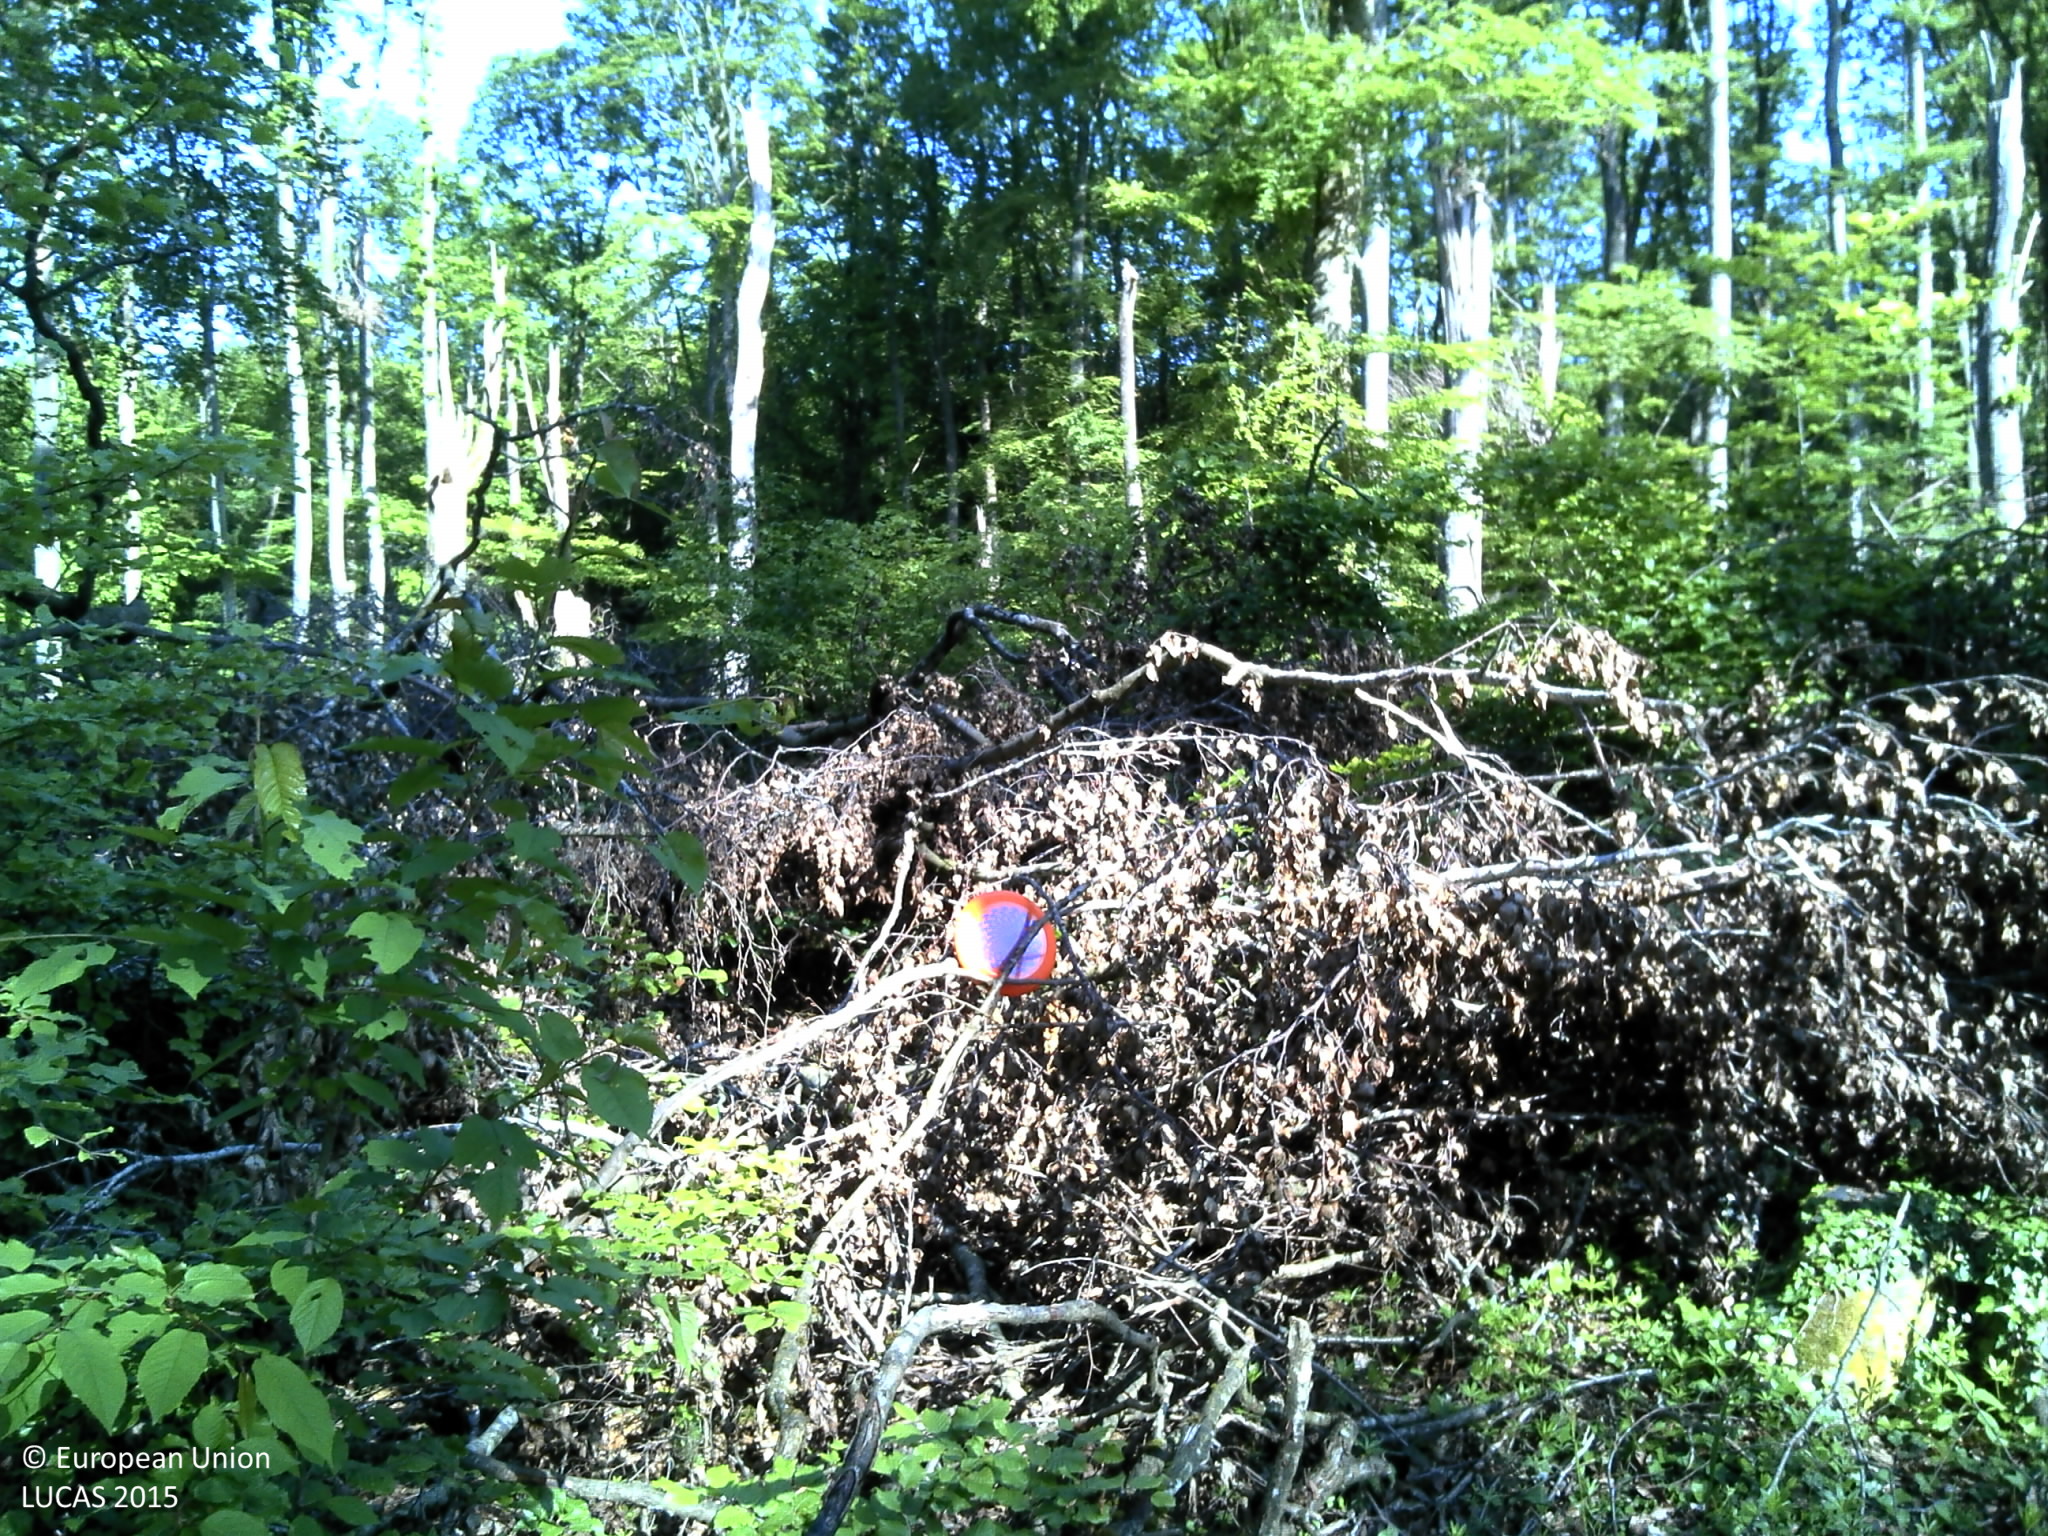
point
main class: Woodland
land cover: Broadleaved woodland
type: beech forest
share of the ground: > 75 %
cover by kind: broadleaved forest trees 100 %
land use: Forestry
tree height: > 5 m
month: May
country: LU
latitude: 49.6808
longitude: 5.9661
